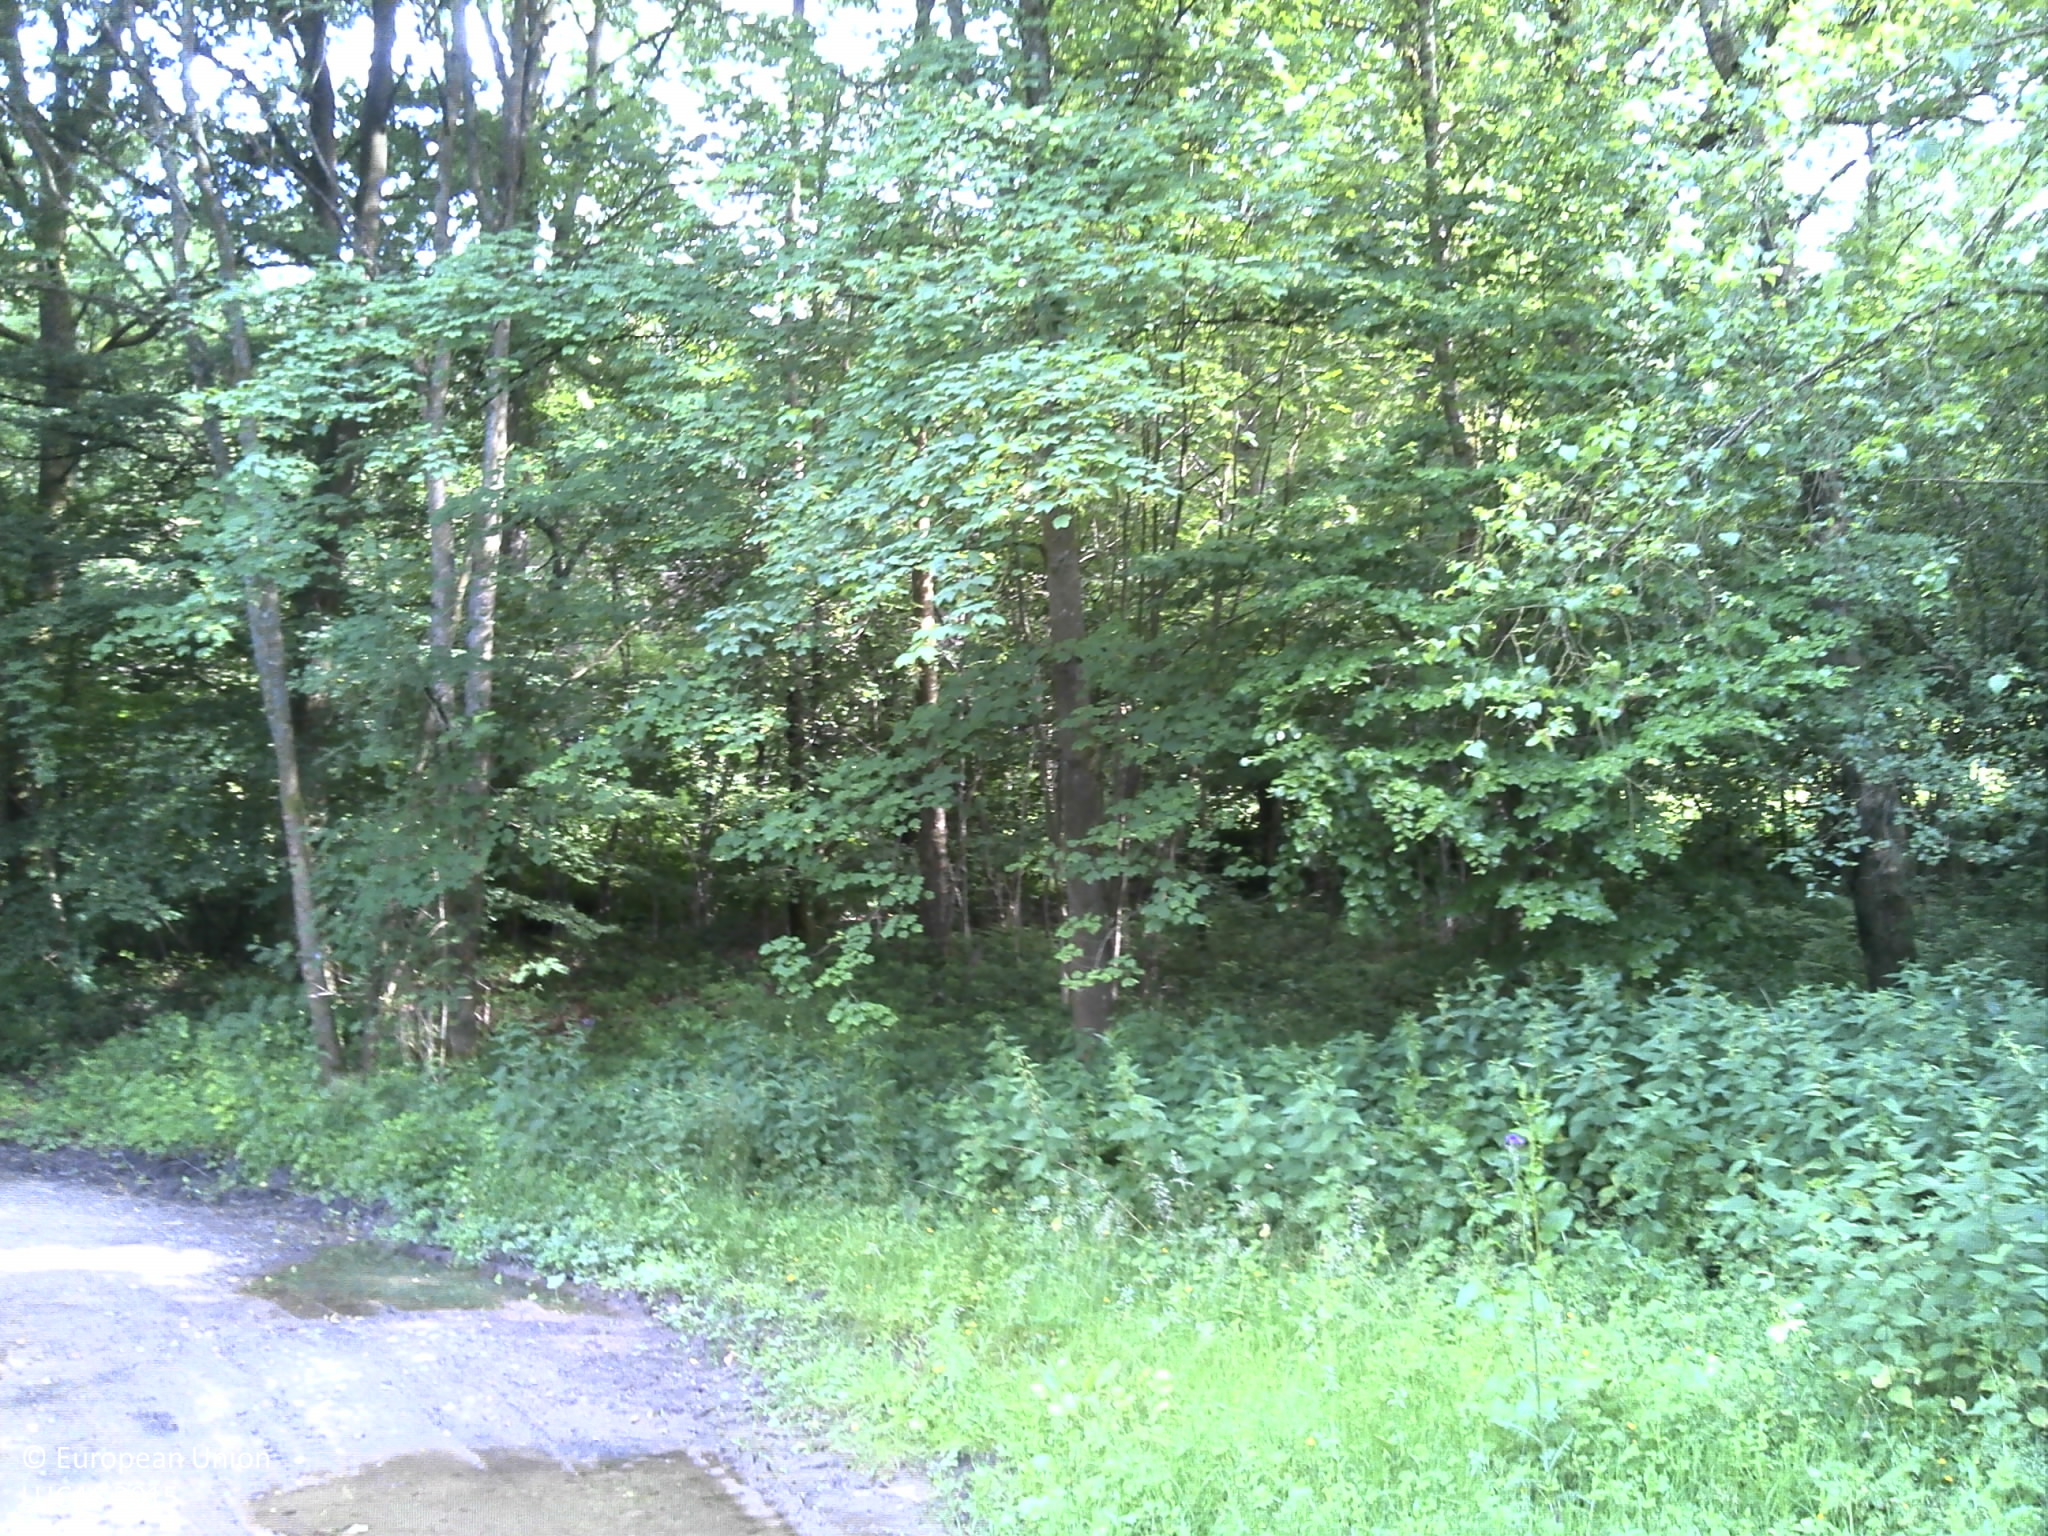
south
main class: Woodland
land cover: Spruce dominated coniferous woodland
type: mountainous beech forest
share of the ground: 25 - 50 %
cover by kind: coniferous forest trees 60 %, herbaceous plants 25 %, broadleaved forest trees 10 %, lichens and mosses 5 %
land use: Forestry
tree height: > 5 m
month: June
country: FR
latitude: 49.8919
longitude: 4.5535
